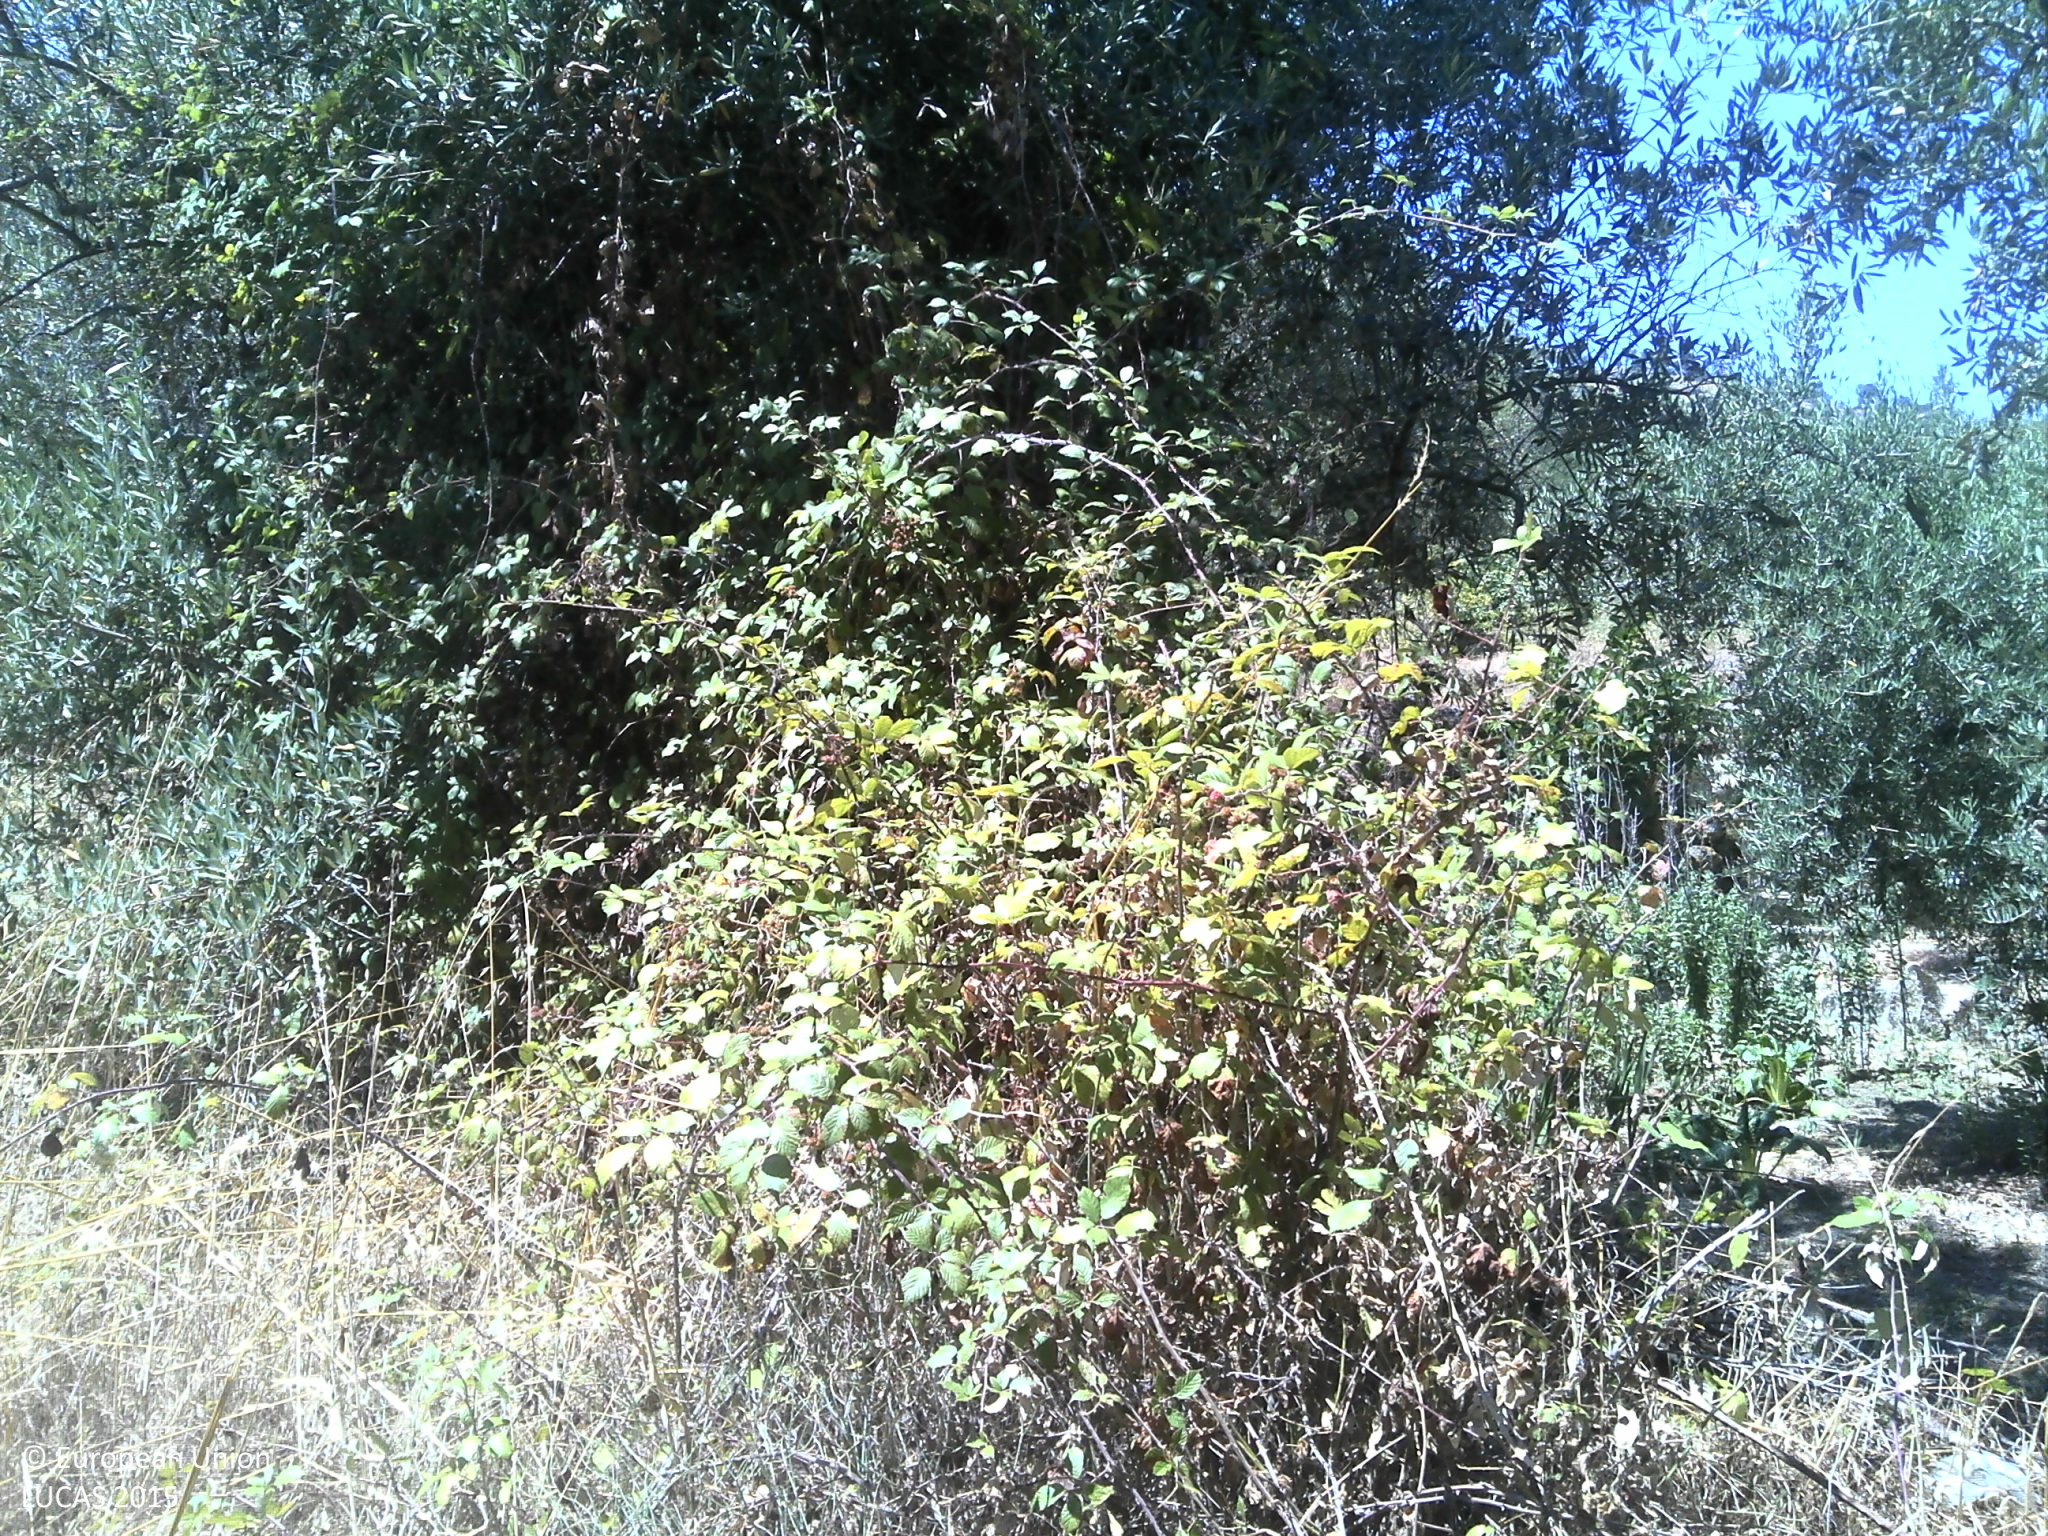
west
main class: Cropland
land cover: Olive groves
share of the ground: 50 - 75 %
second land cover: Grassland without tree/shrub cover
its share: 50 - 75 %
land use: Agriculture (excluding fallow land and kitchen gardens)
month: August
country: PT
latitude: 40.5770
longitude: -7.3197
